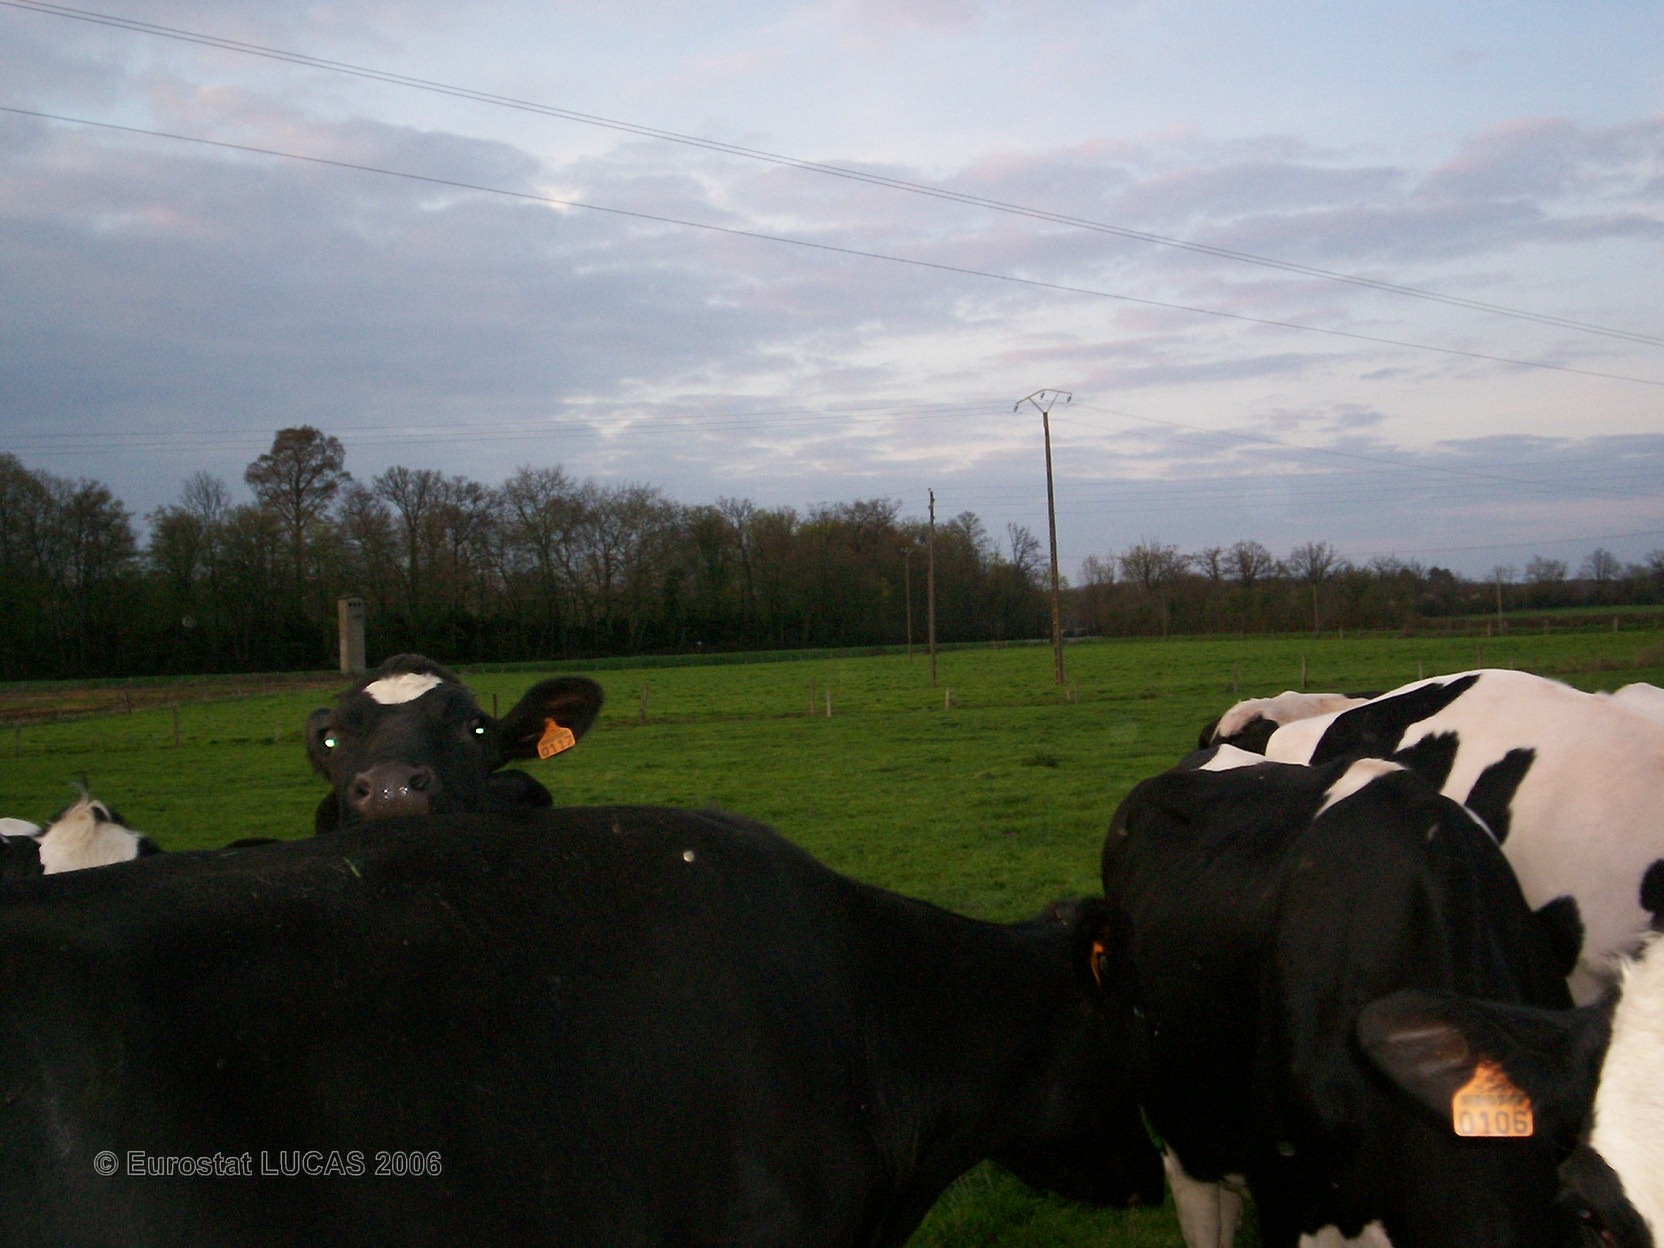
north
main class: Grassland
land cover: Grassland without tree/shrub cover
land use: Agriculture (excluding fallow land and kitchen gardens)
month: April
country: FR
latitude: 48.3041
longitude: 0.1169
